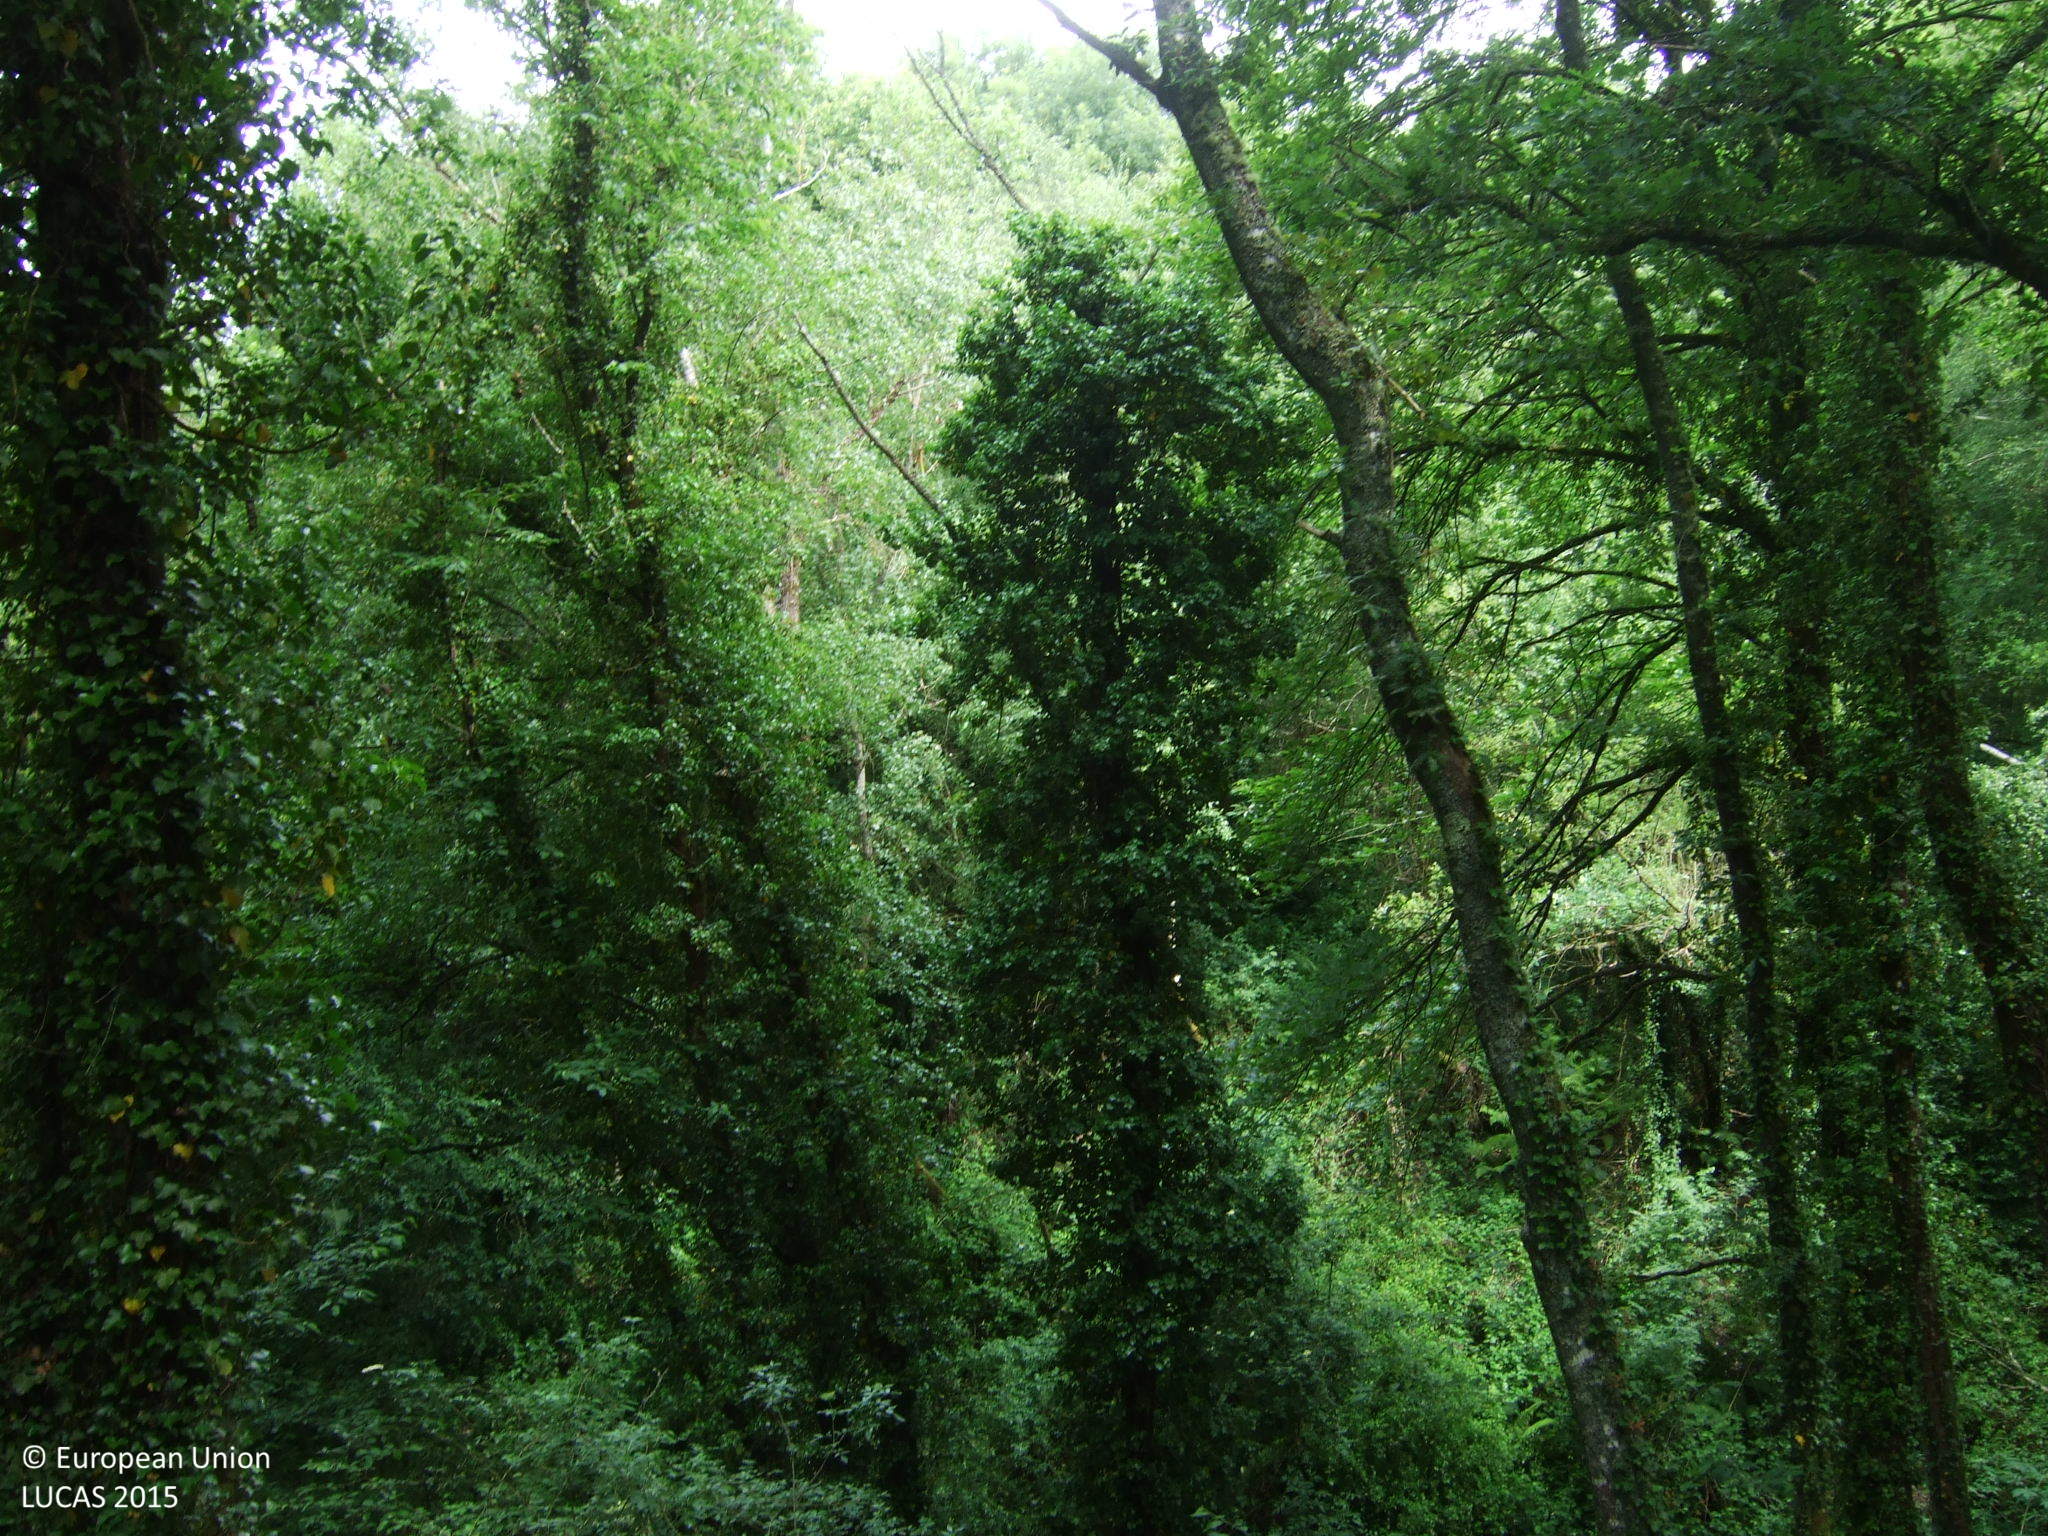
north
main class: Woodland
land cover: Broadleaved woodland
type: acidophilous oak and oak-birch forest
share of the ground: > 75 %
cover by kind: broadleaved forest trees 80 %, shrubs 20 %
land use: Forestry
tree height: > 5 m
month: June
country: ES
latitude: 42.7497
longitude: -7.3307
